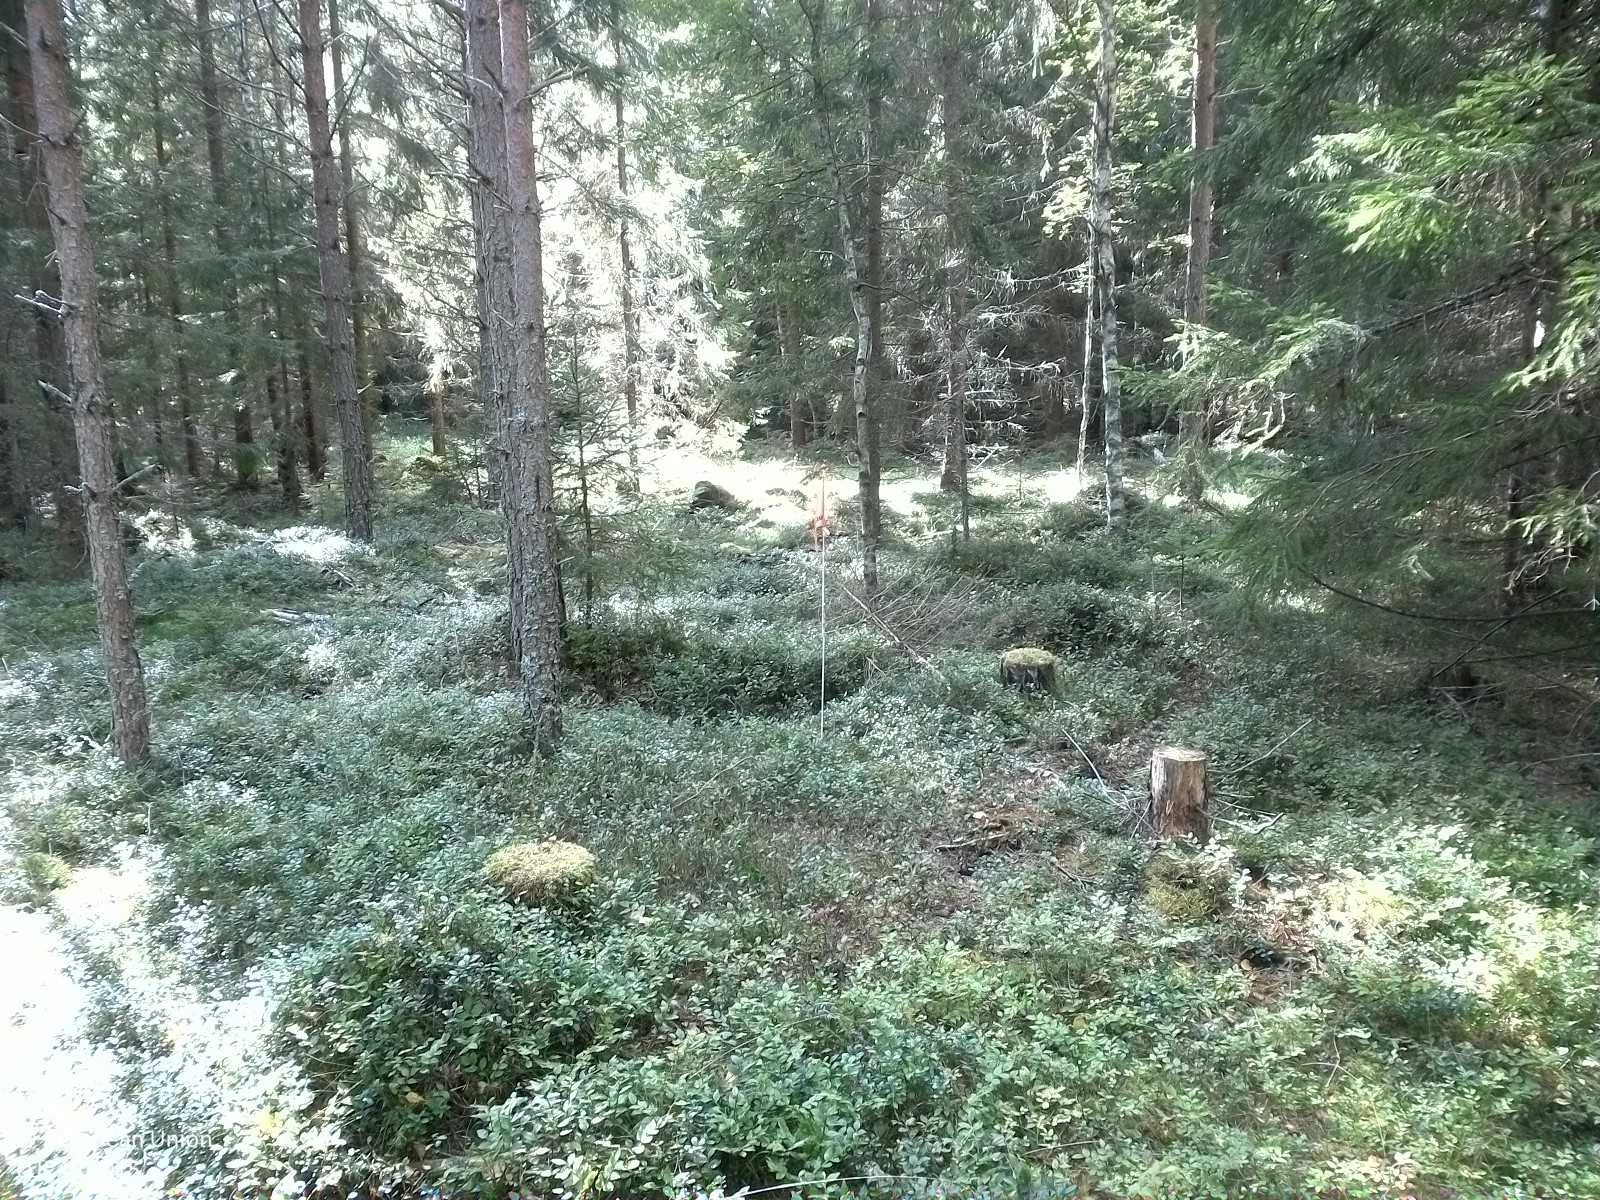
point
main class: Woodland
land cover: Other mixed woodland
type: boreal forest
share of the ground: 25 - 50 %
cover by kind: herbaceous plants 40 %, coniferous forest trees 30 %, broadleaved forest trees 15 %, lichens and mosses 15 %
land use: Forestry
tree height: > 5 m
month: August
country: SE
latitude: 59.0235
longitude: 15.5843
